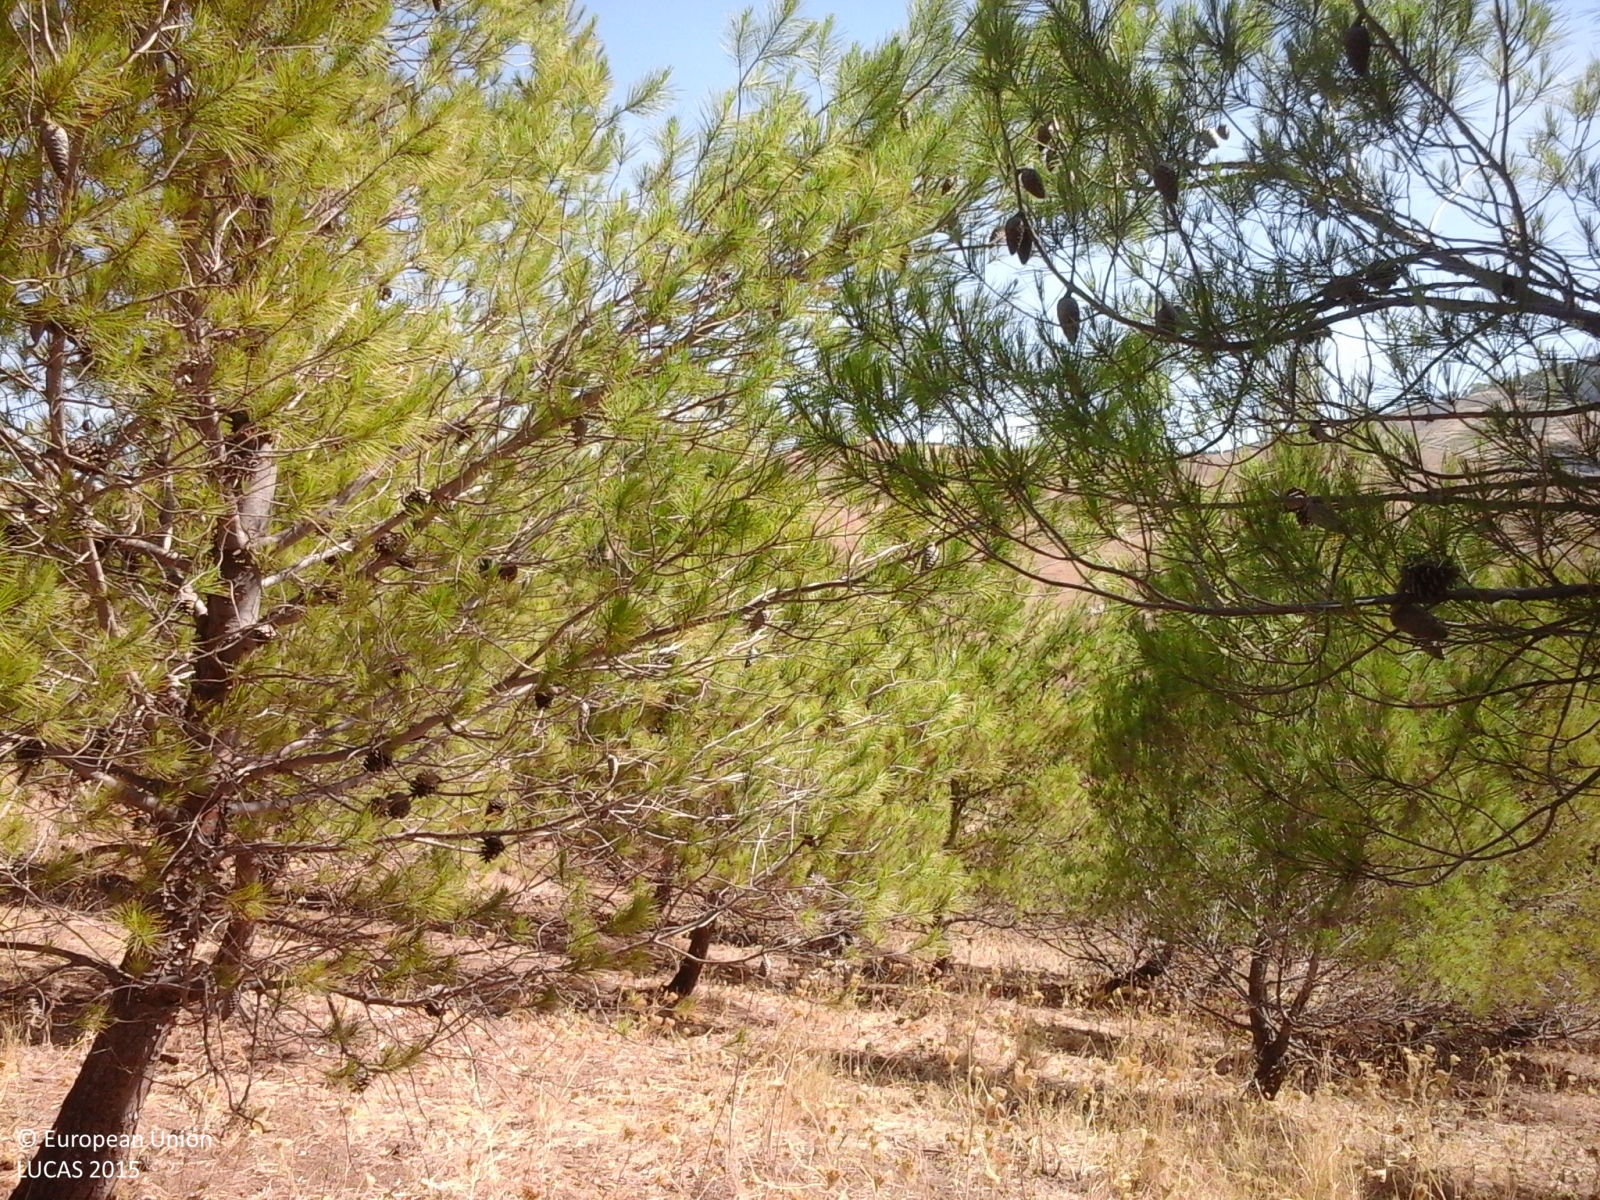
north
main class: Woodland
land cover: Pine dominated coniferous woodland
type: coniferous forest of the mediterranean region
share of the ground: 50 - 75 %
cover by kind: coniferous forest trees 80 %, herbaceous plants 20 %
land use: Forestry
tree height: > 5 m
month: June
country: IT
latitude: 37.4530
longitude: 13.3318
